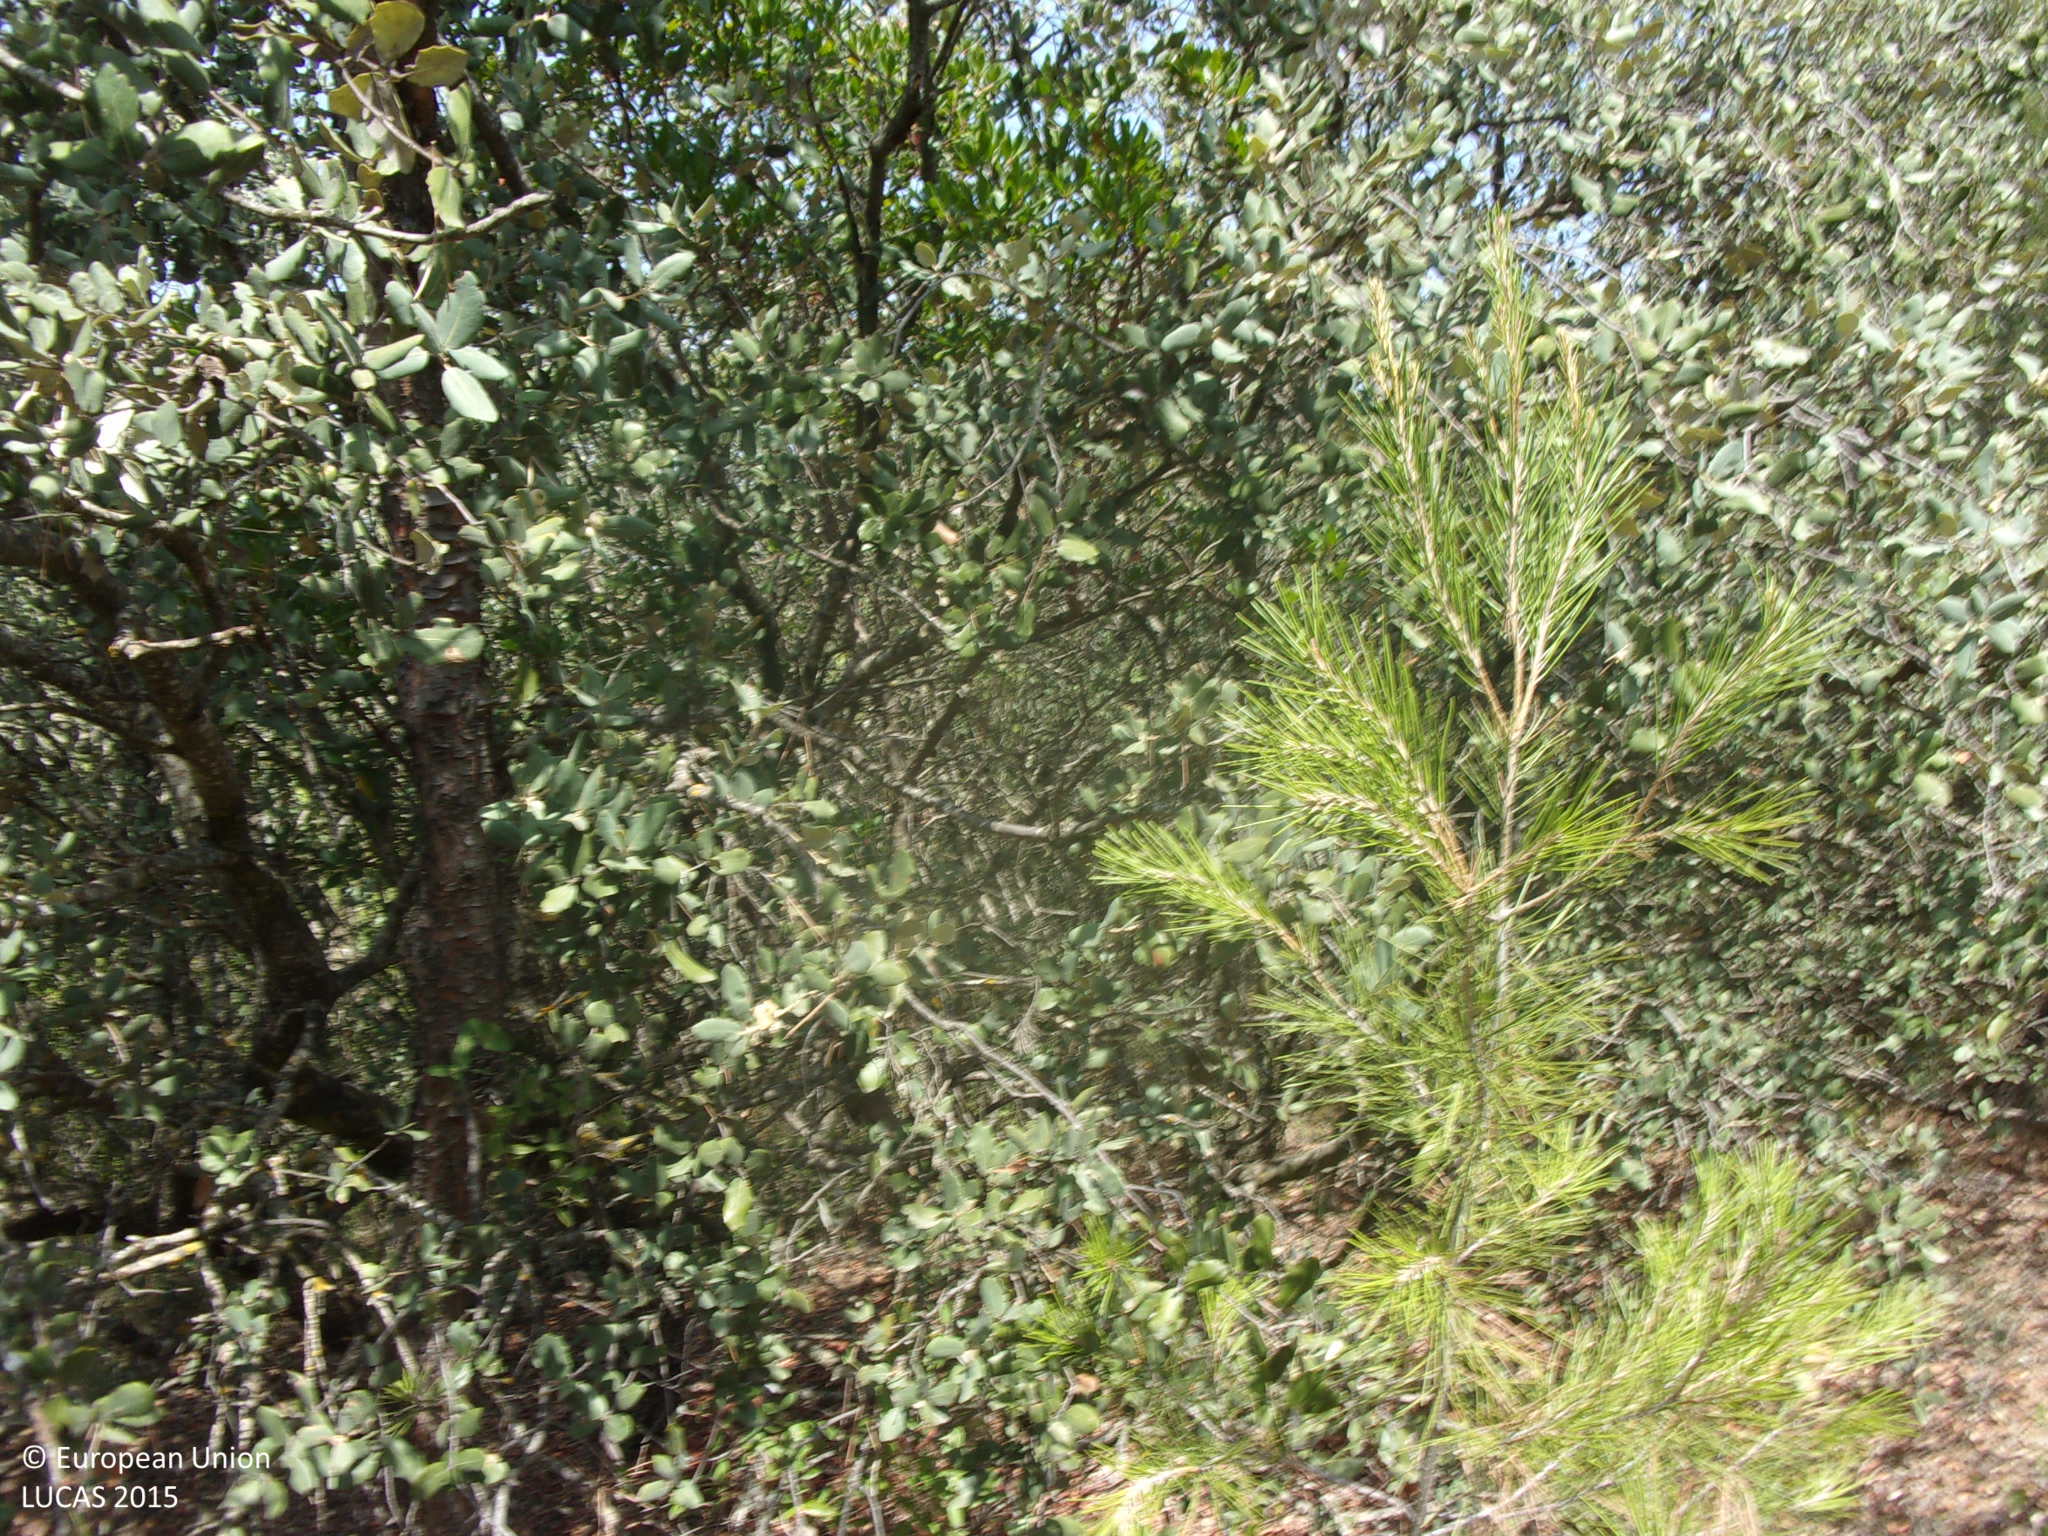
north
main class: Woodland
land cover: Pine dominated mixed woodland
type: coniferous forest of the mediterranean region
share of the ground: > 75 %
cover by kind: coniferous forest trees 60 %, broadleaved forest trees 30 %, shrubs 10 %
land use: Forestry
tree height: < 5 m
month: August
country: ES
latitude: 42.4810
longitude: -1.4079
